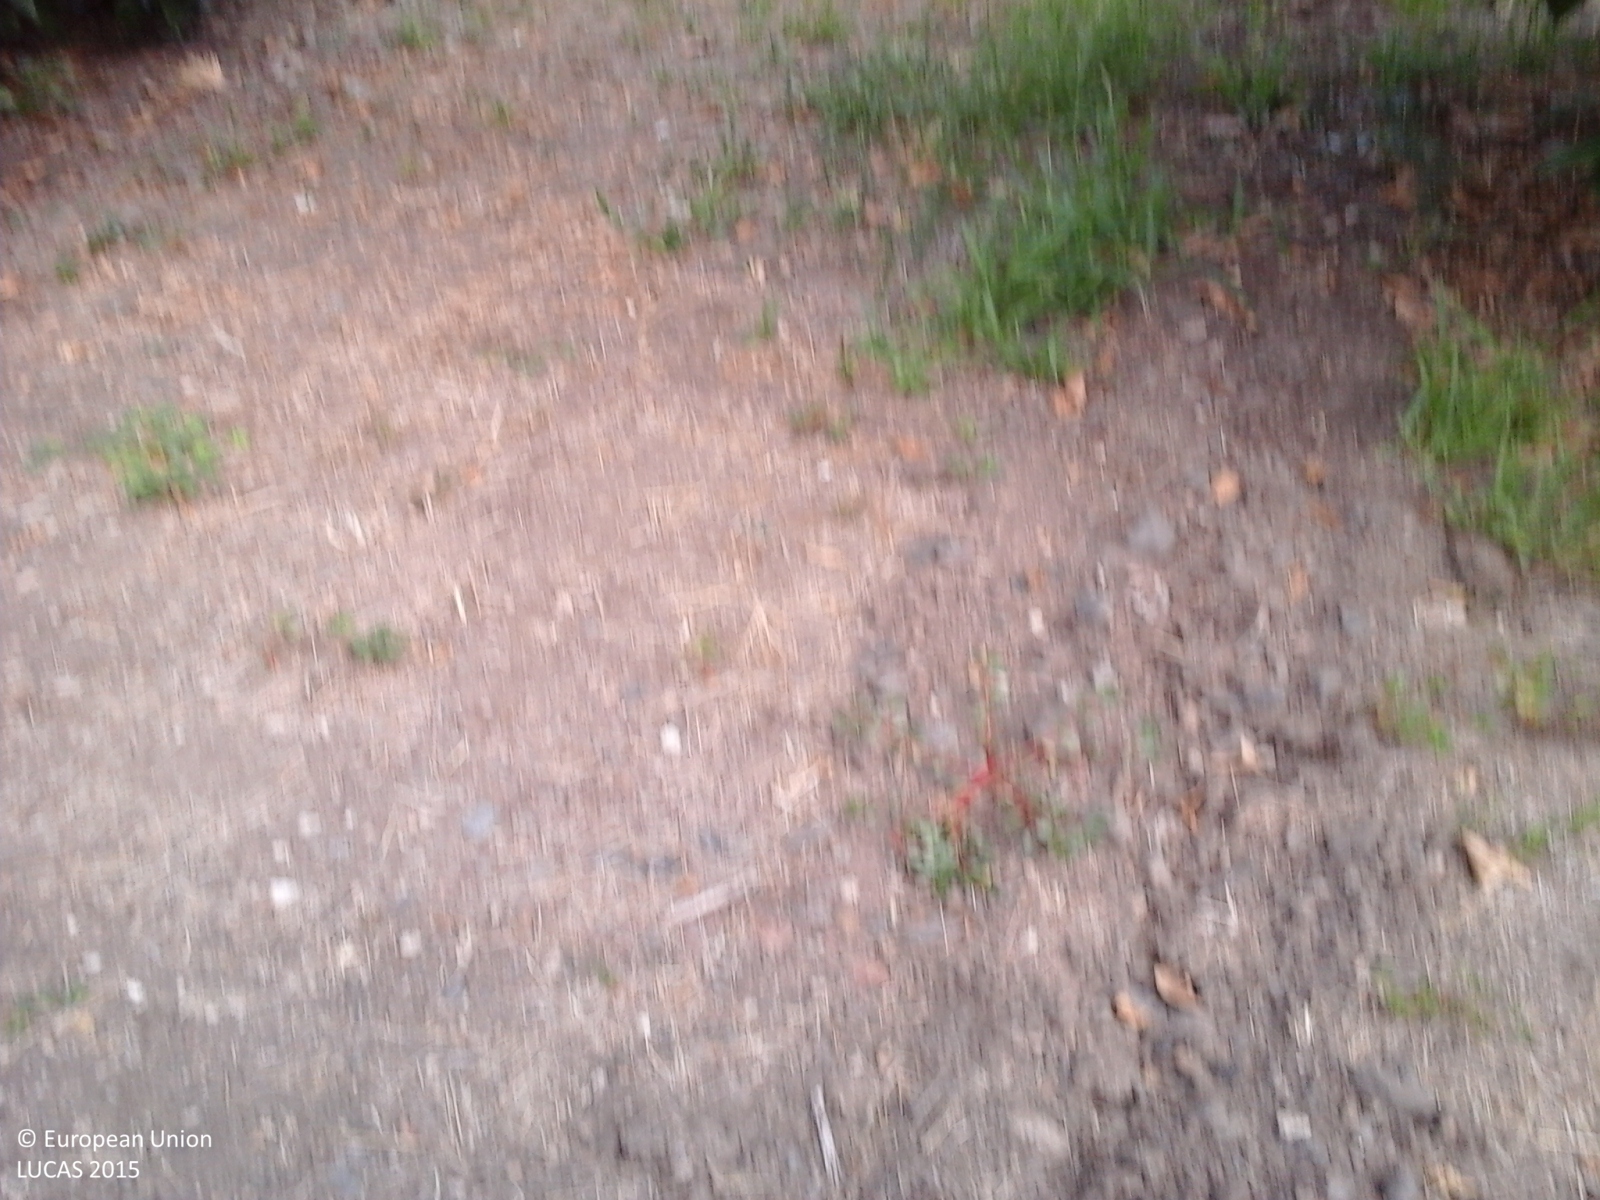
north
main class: Cropland
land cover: Oranges
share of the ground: > 75 %
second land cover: Spontaneously vegetated surfaces
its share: > 75 %
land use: Agriculture (excluding fallow land and kitchen gardens)
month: August
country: IT
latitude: 37.2953
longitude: 14.8708
